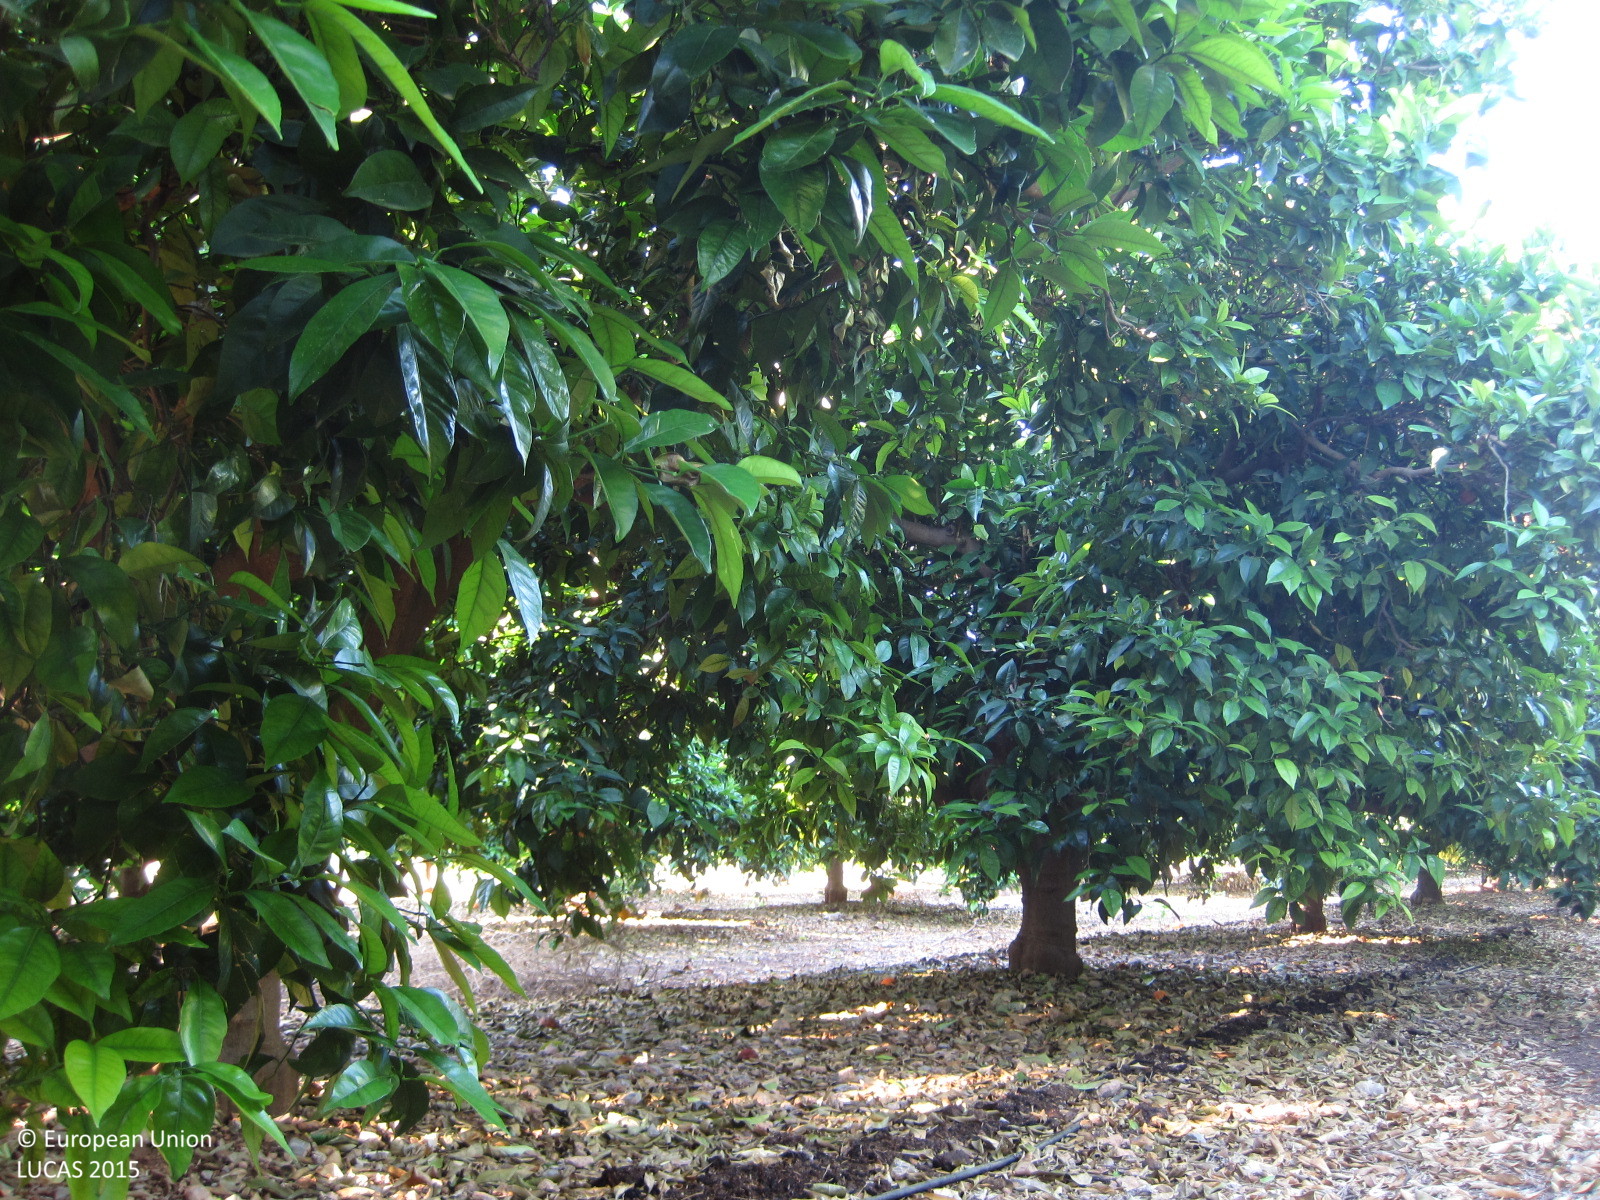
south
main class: Cropland
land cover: Oranges
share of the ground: > 75 %
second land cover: Other bare soil
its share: > 75 %
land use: Agriculture (excluding fallow land and kitchen gardens)
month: May
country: ES
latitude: 39.7171
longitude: -0.6986
